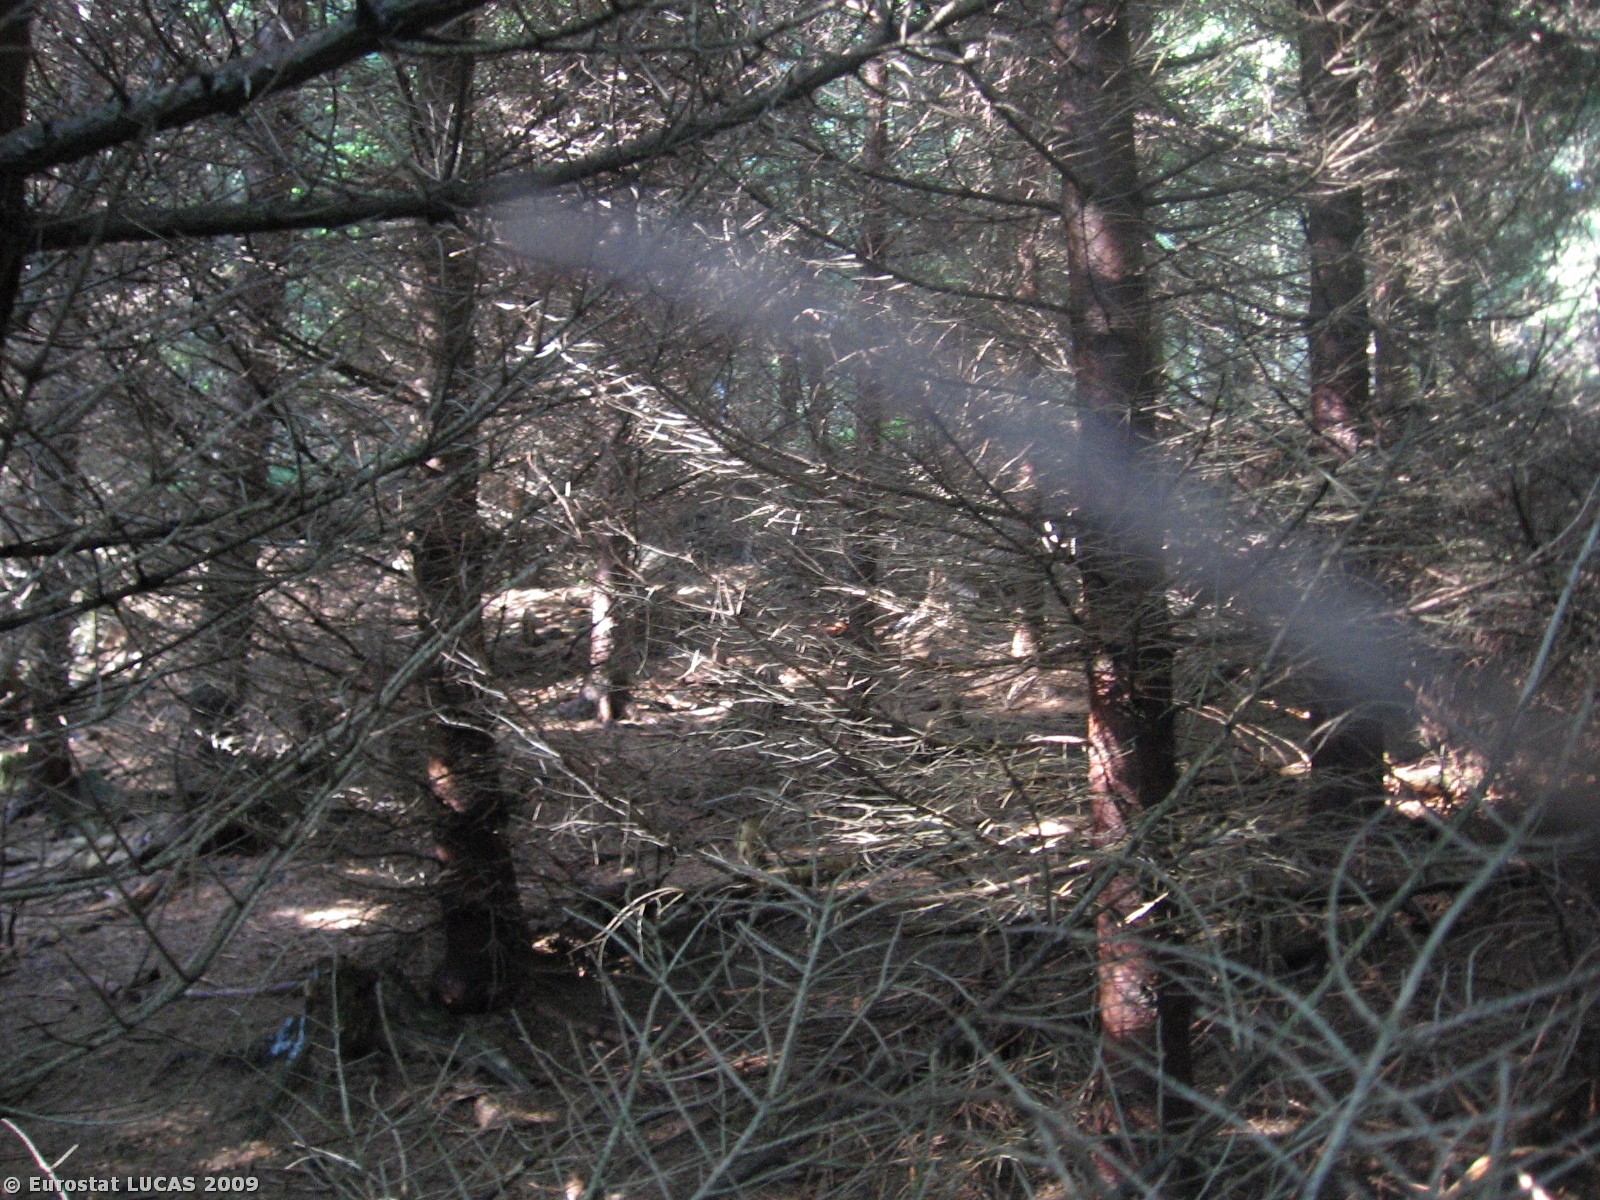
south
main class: Woodland
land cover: Coniferous woodland
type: hemiboreal forest and nemoral coniferous forest and mixed broadleaved-coniferous forest
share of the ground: > 75 %
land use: Forestry
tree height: > 5 m
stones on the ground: < 10 %
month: July
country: CZ
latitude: 49.2582
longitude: 13.1738
